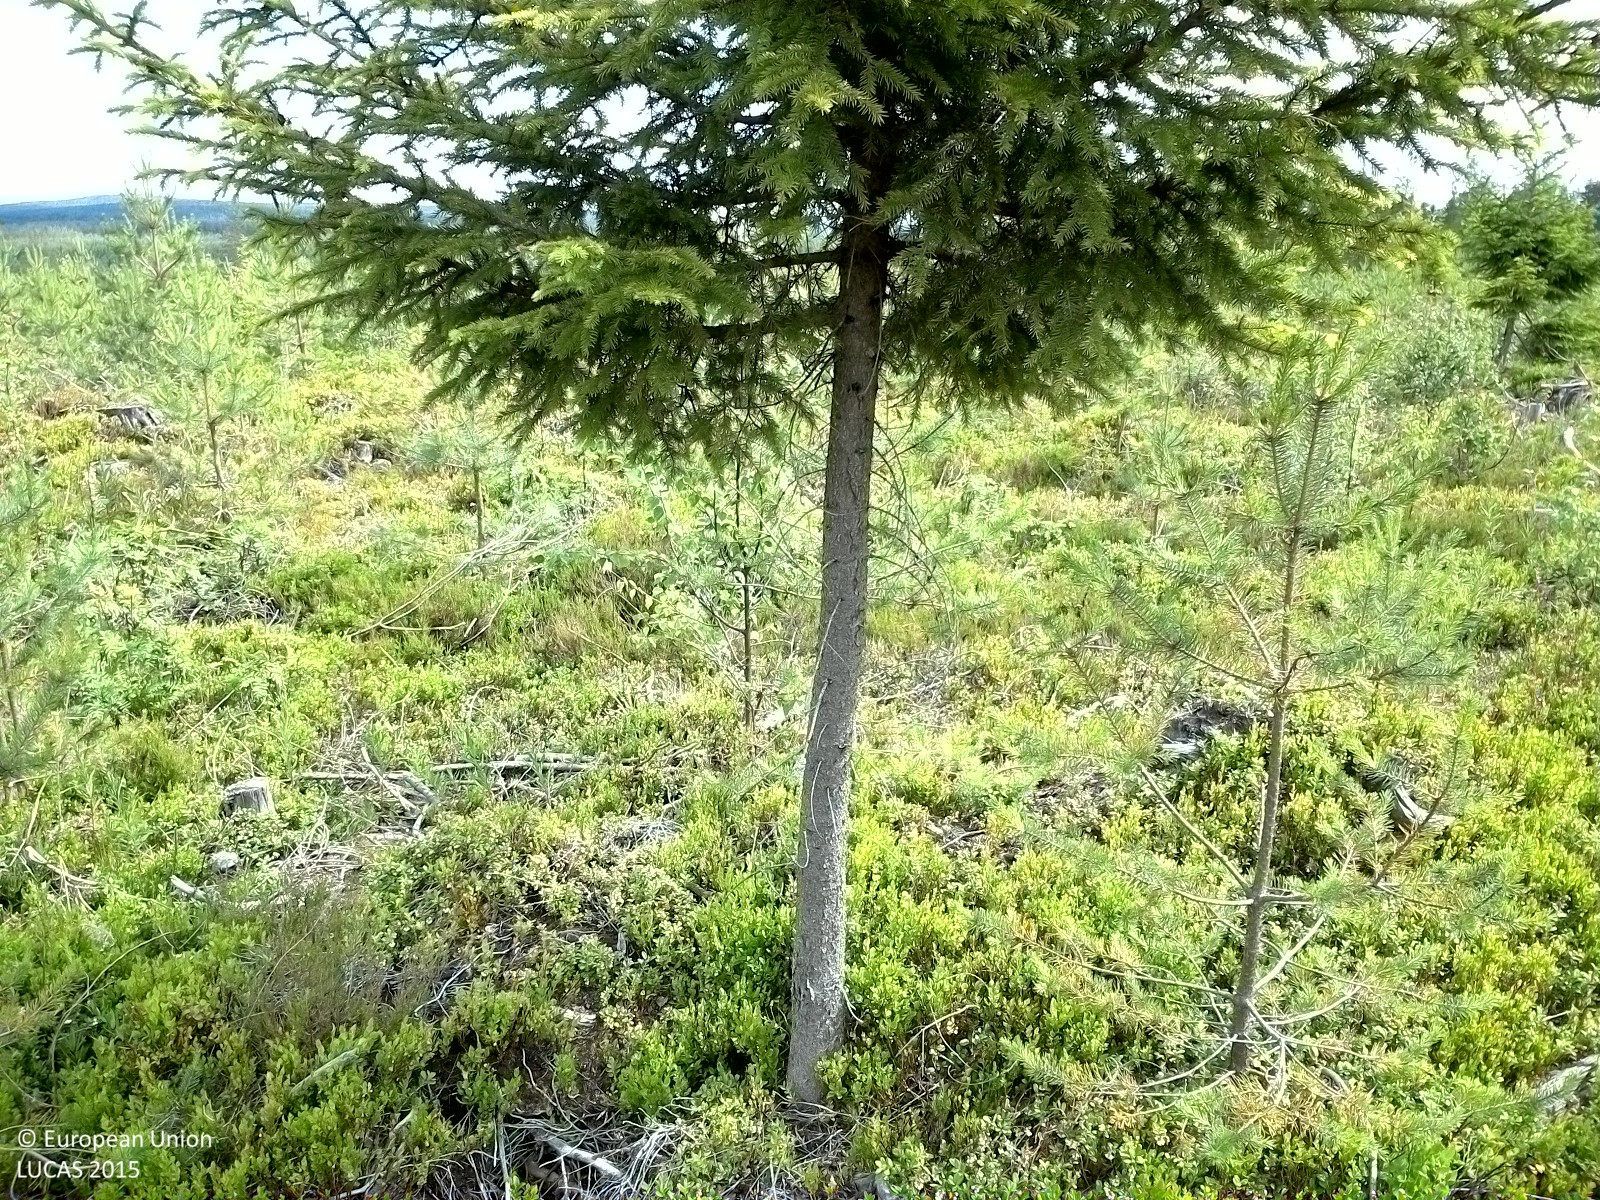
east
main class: Woodland
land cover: Pine dominated mixed woodland
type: boreal forest
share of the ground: 25 - 50 %
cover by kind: shrubs 65 %, coniferous forest trees 25 %, broadleaved forest trees 10 %
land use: Forestry
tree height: < 5 m
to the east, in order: Pine dominated mixed woodland; Broadleaved woodland; Other mixed woodland
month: July
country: SE
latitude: 62.1335
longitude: 17.1733
